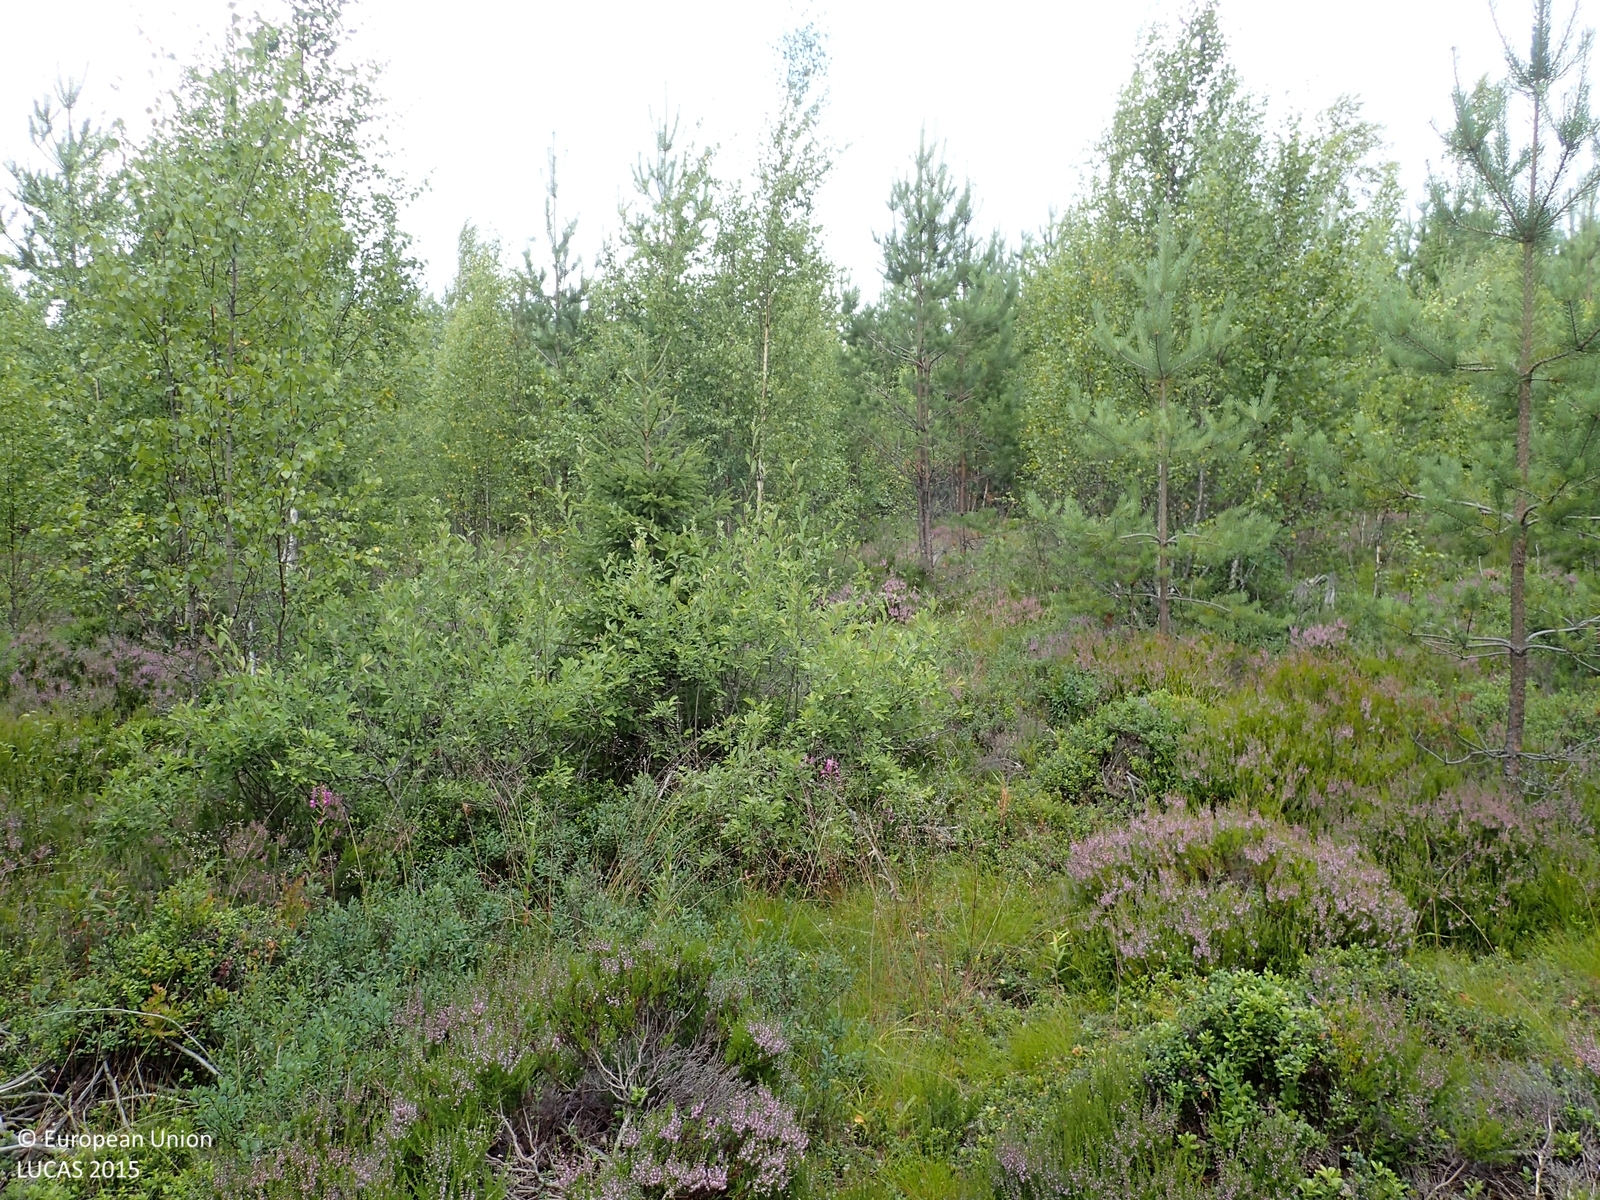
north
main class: Woodland
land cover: Pine dominated mixed woodland
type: boreal forest
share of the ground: 50 - 75 %
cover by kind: shrubs 45 %, broadleaved forest trees 30 %, coniferous forest trees 25 %
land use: Forestry
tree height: < 5 m
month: August
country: FI
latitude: 62.6247
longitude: 21.7612
